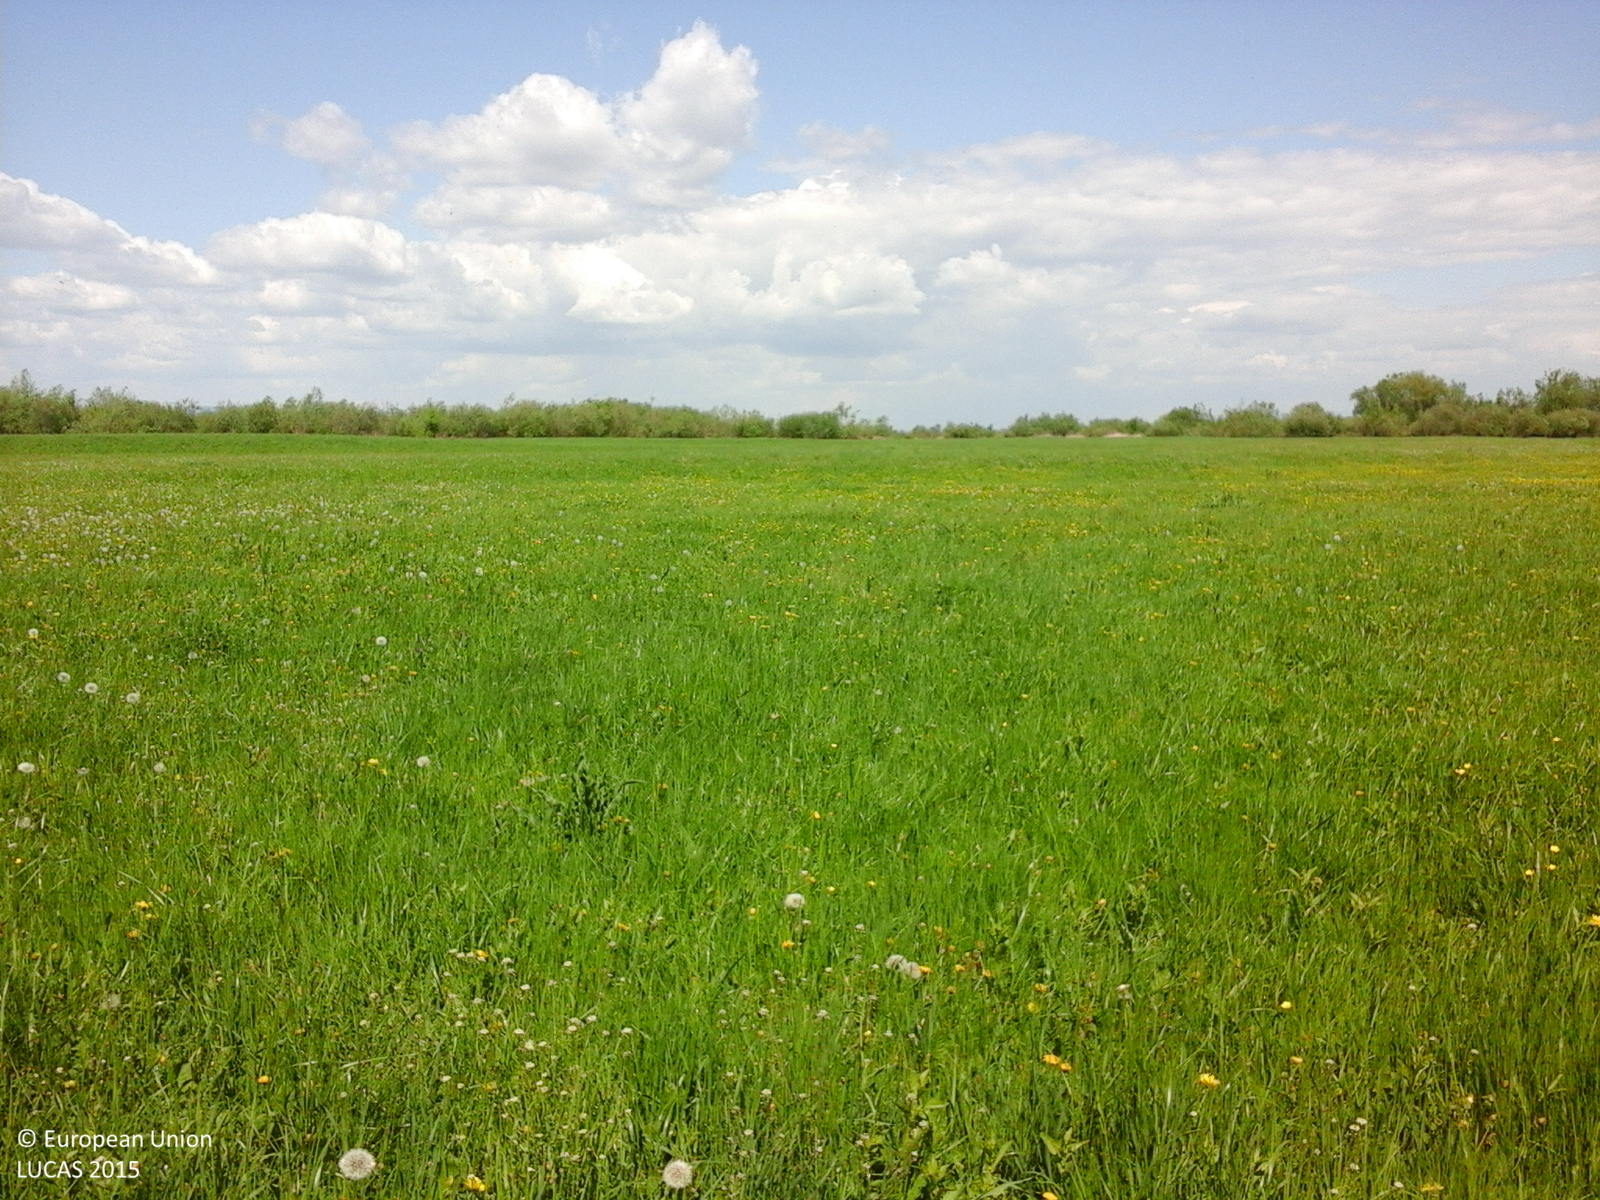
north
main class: Grassland
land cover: Grassland without tree/shrub cover
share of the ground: > 75 %
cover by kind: herbaceous plants 100 %
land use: Agriculture (excluding fallow land and kitchen gardens)
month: May
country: RO
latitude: 45.7610
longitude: 25.7563
